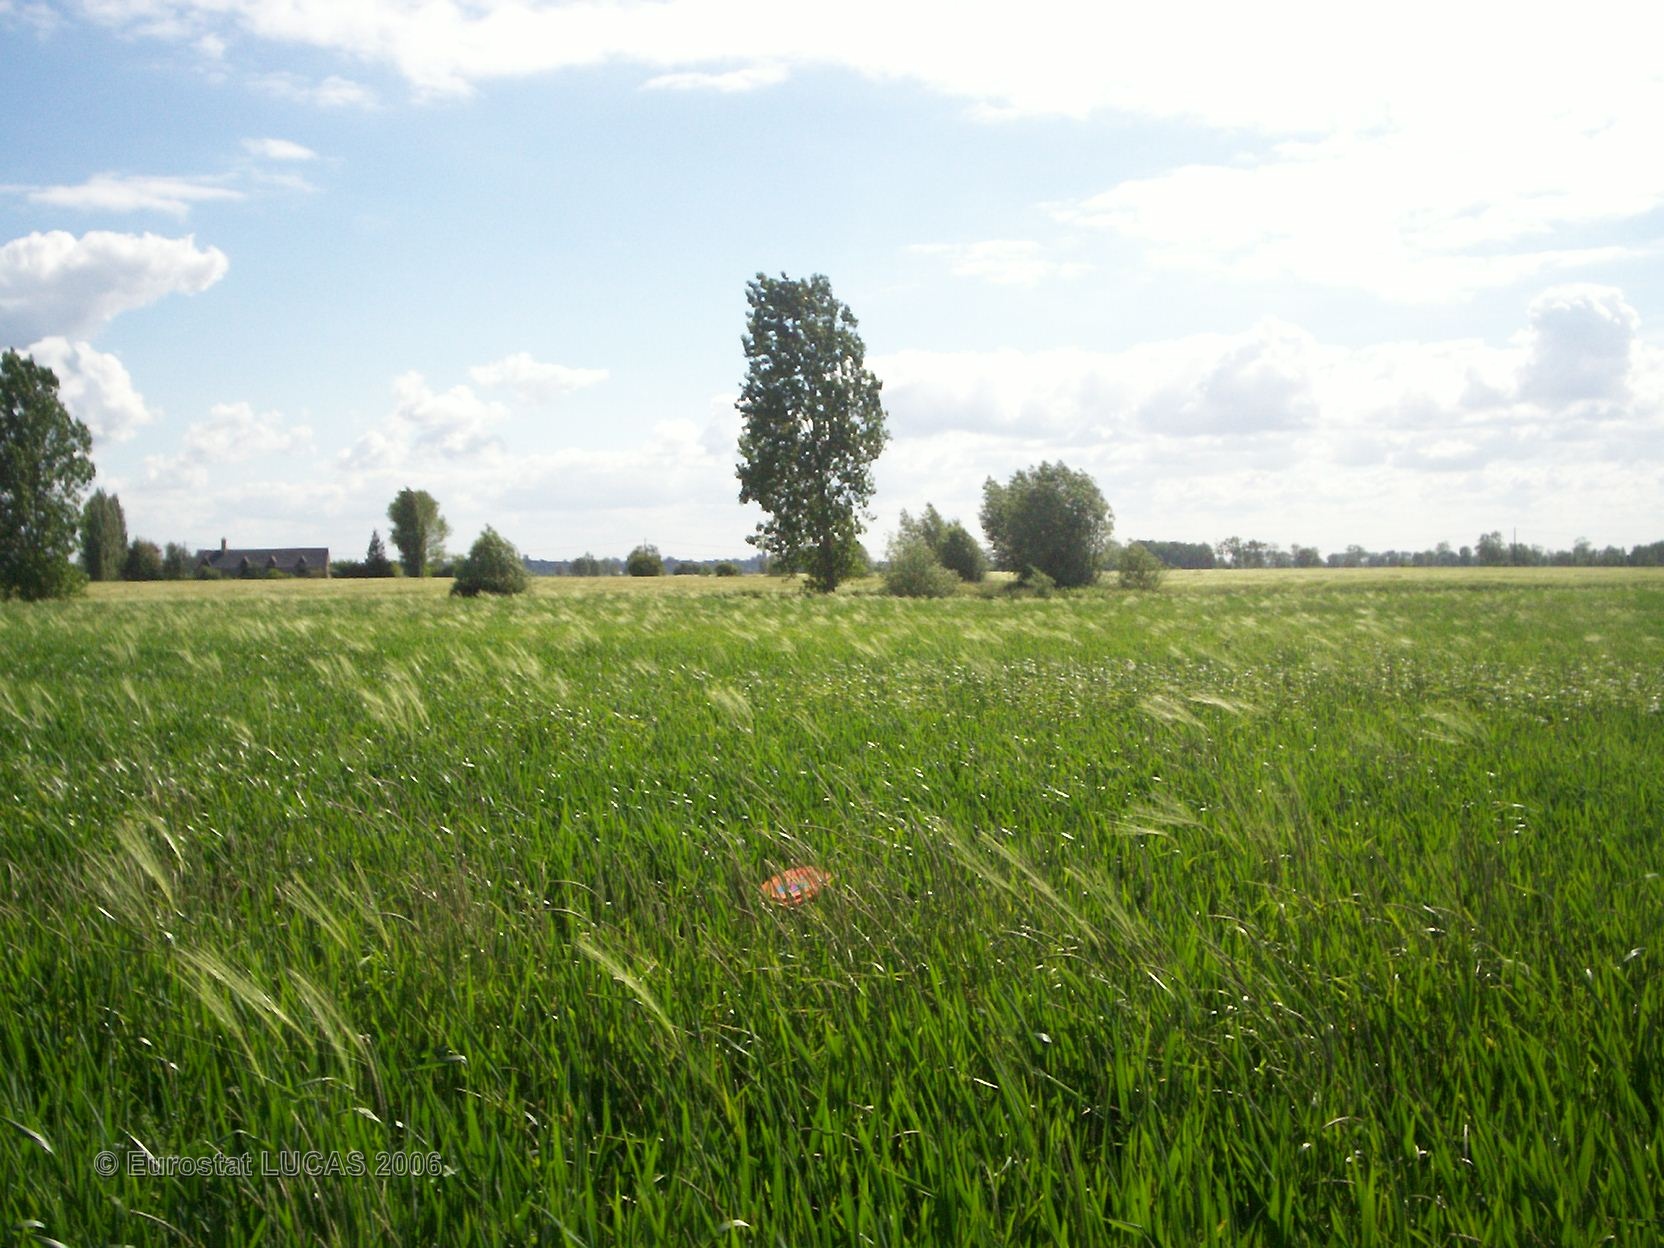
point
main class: Cropland
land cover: Common wheat
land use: Agriculture (excluding fallow land and kitchen gardens)
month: May
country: FR
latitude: 48.5776
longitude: -1.7207
